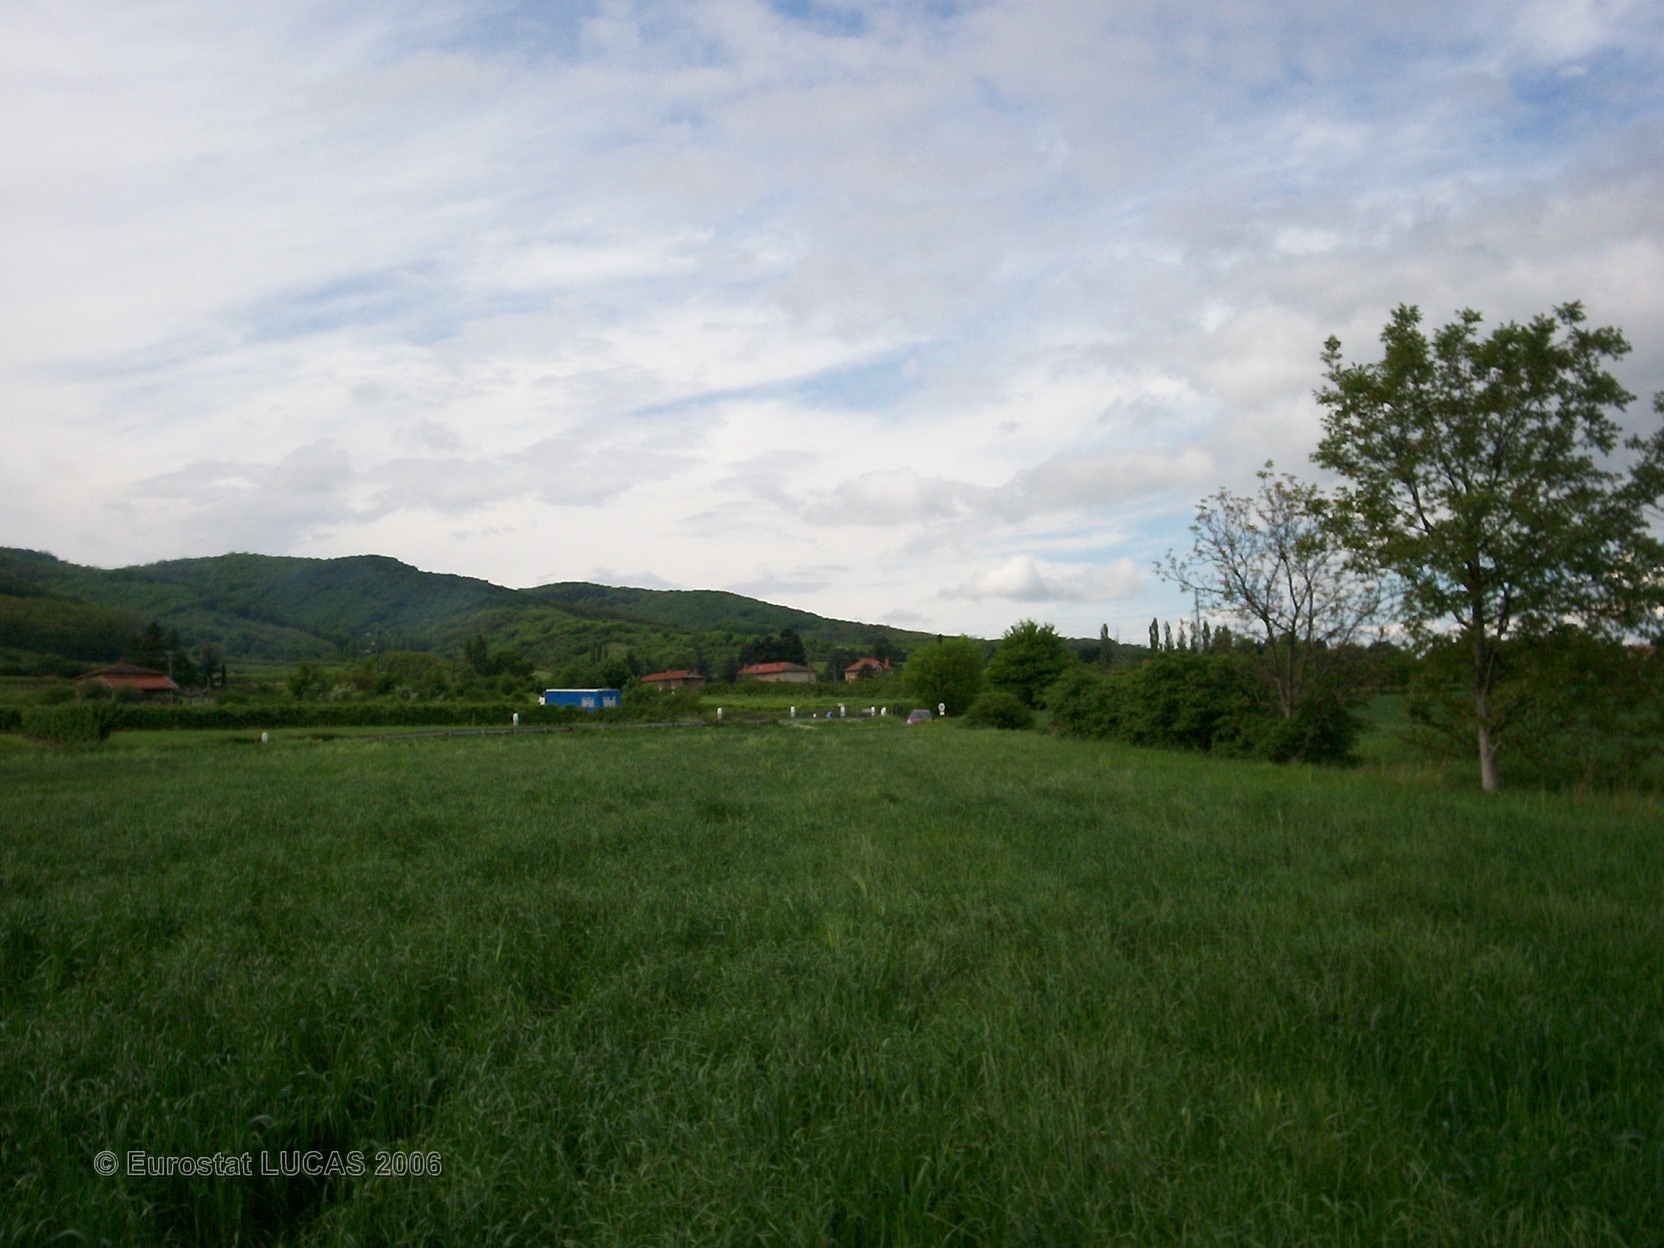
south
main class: Grassland
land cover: Grassland without tree/shrub cover
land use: Agriculture (excluding fallow land and kitchen gardens)
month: May
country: FR
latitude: 45.8811
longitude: 4.7848
